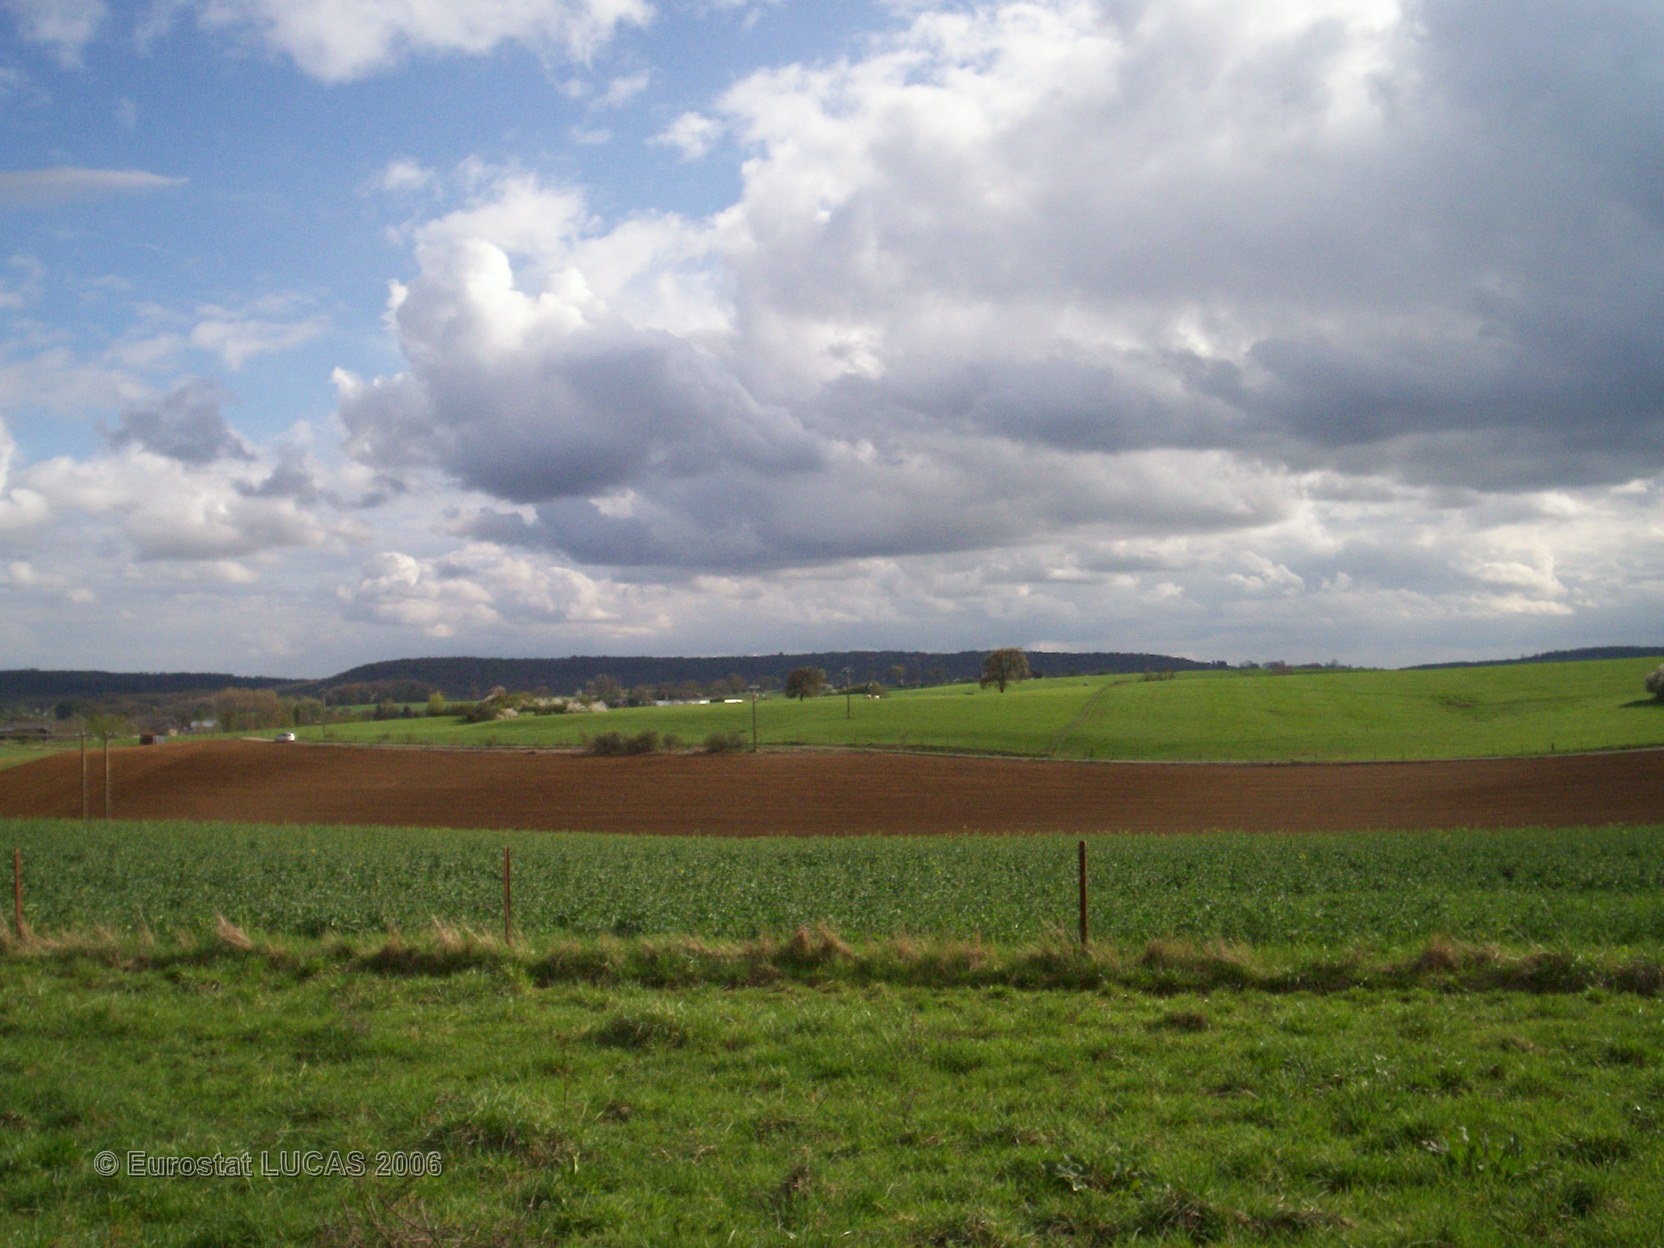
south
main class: Grassland
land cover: Grassland without tree/shrub cover
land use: Agriculture (excluding fallow land and kitchen gardens)
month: April
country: FR
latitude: 49.6754
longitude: 4.5502
